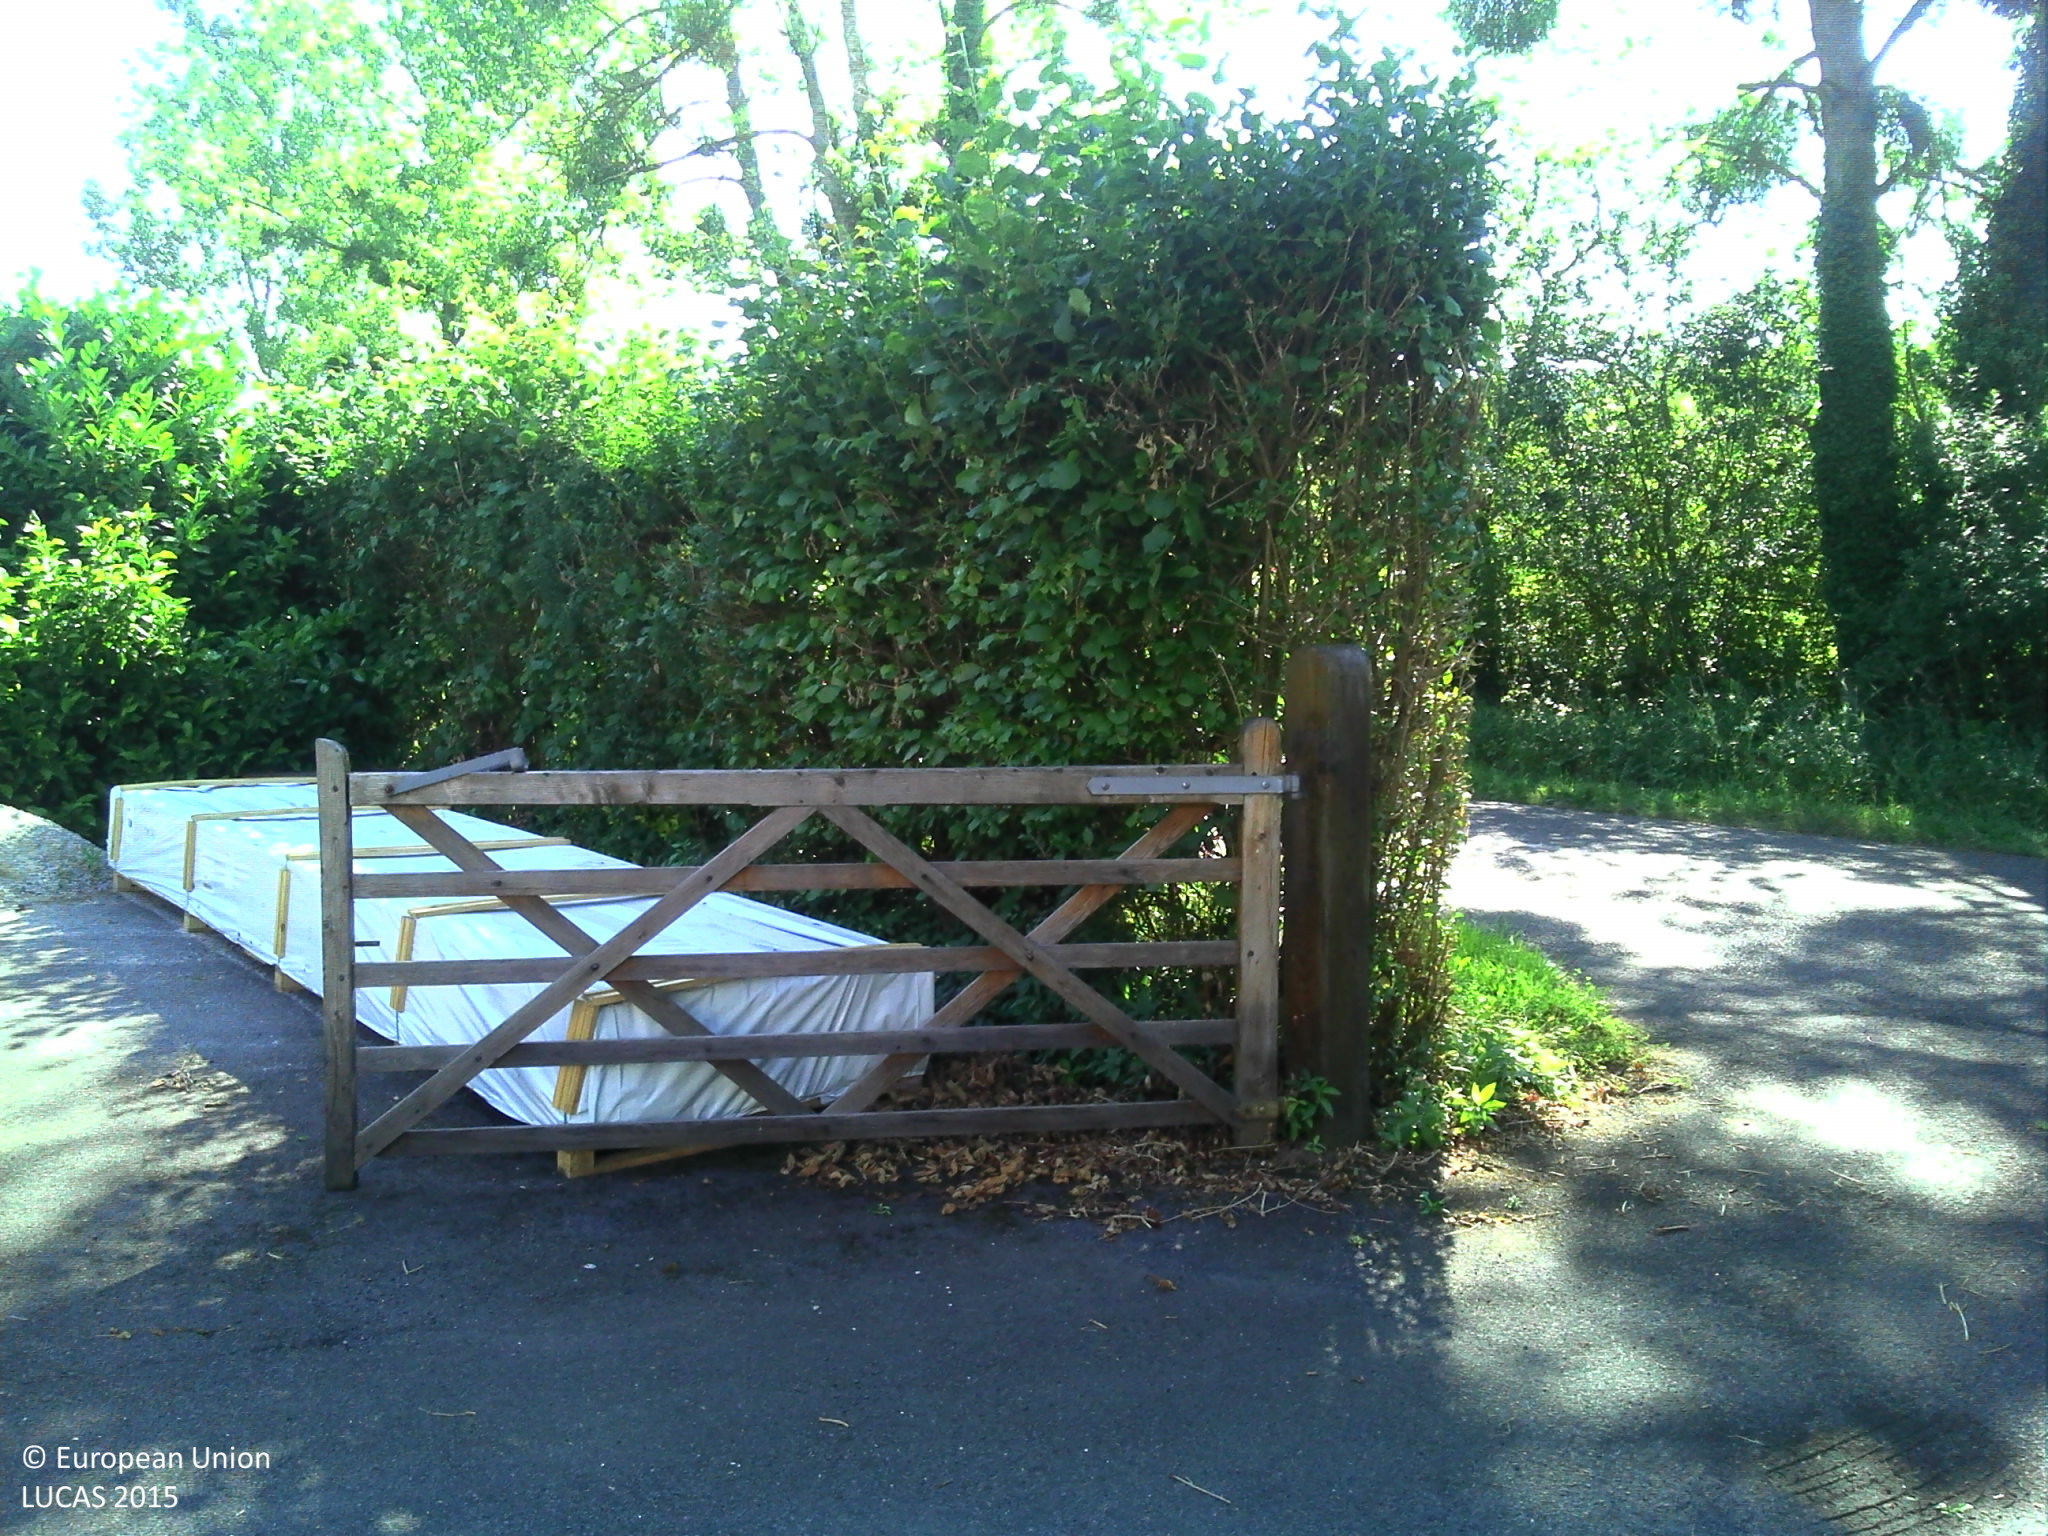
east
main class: Grassland
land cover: Grassland without tree/shrub cover
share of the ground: > 75 %
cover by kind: herbaceous plants 100 %
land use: Residential
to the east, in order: Grassland without tree/shrub cover; Artificial constructions in urban areas; Lines of trees; Grass margins; Paved roads, cycling and walking lanes; Grass margins; Fences; Lines of trees; Grassland without tree/shrub cover; Abandoned hedges; Inland fresh running water; Grassland without tree/shrub cover; Broadleaved woodland
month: July
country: FR
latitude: 48.9724
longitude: 0.5069
